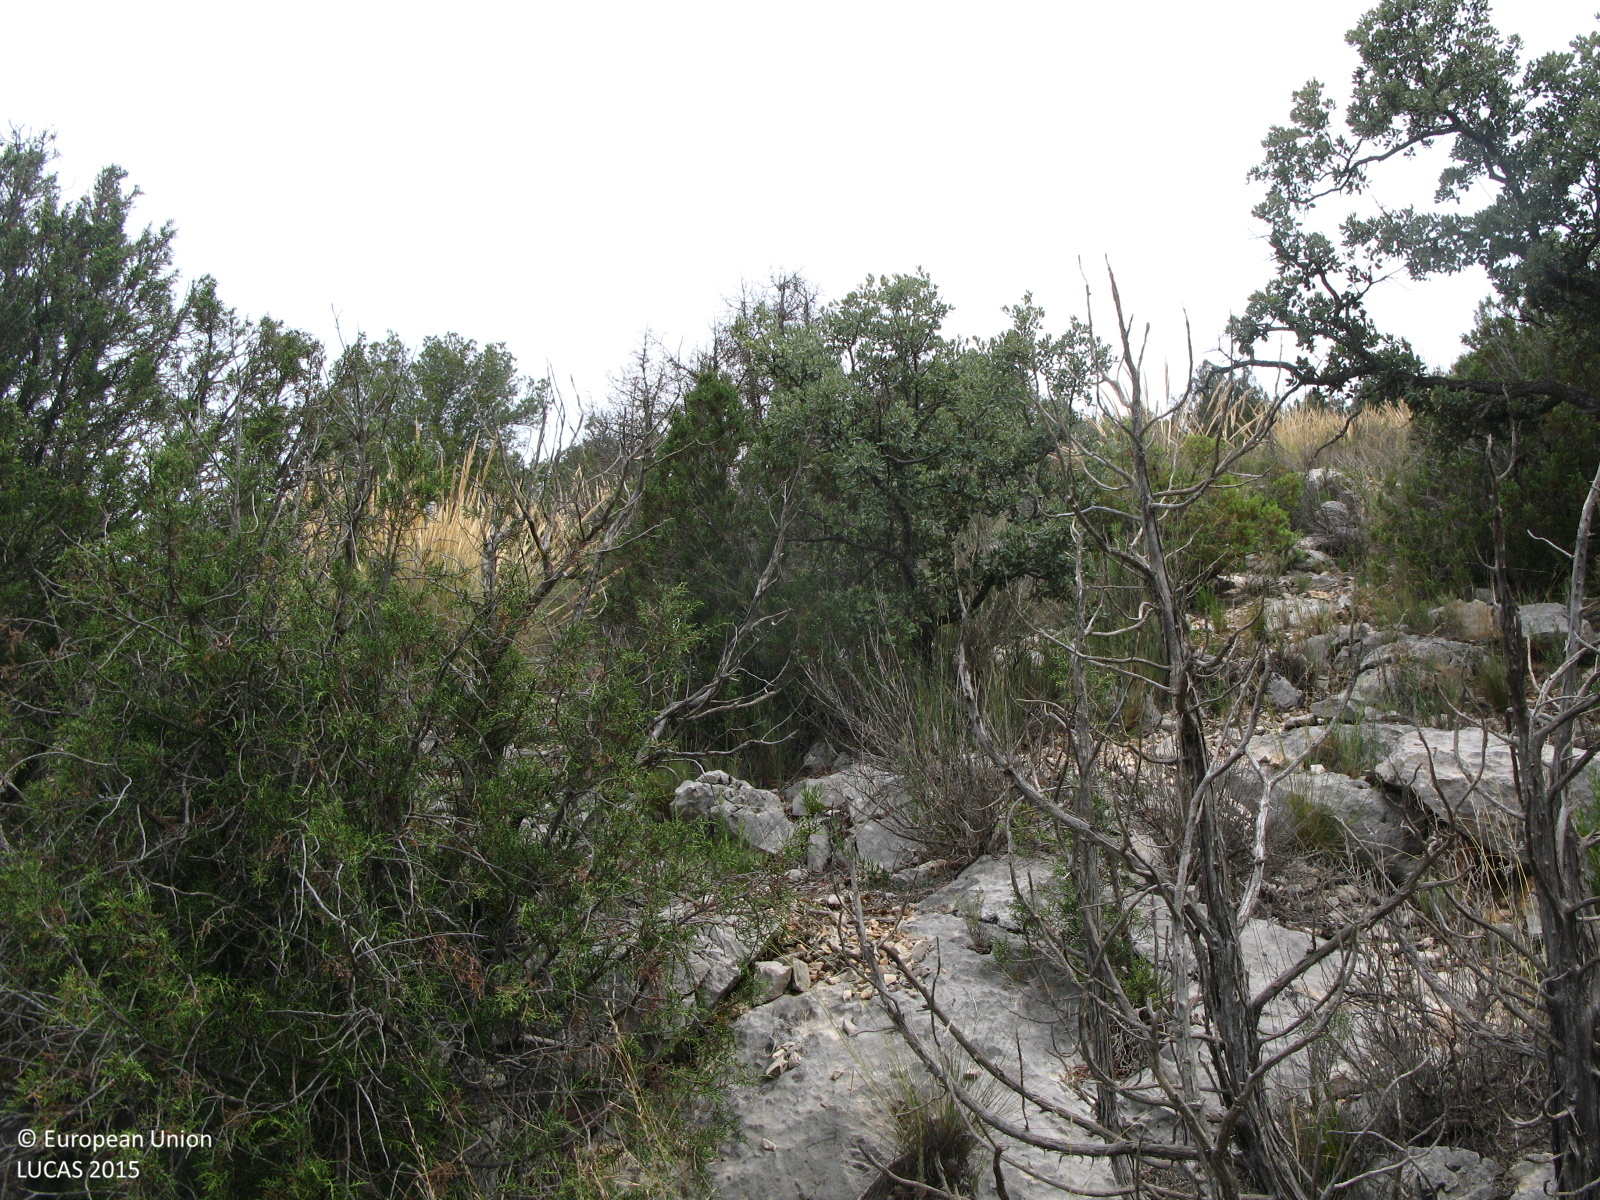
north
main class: Woodland
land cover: Pine dominated coniferous woodland
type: coniferous forest of the mediterranean region
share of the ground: 10 - 25 %
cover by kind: consolidated bare surface 40 %, shrubs 25 %, coniferous forest trees 15 %, herbaceous plants 15 %, broadleaved forest trees 5 %
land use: Forestry
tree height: > 5 m
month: June
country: ES
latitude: 39.9541
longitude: -1.1857
